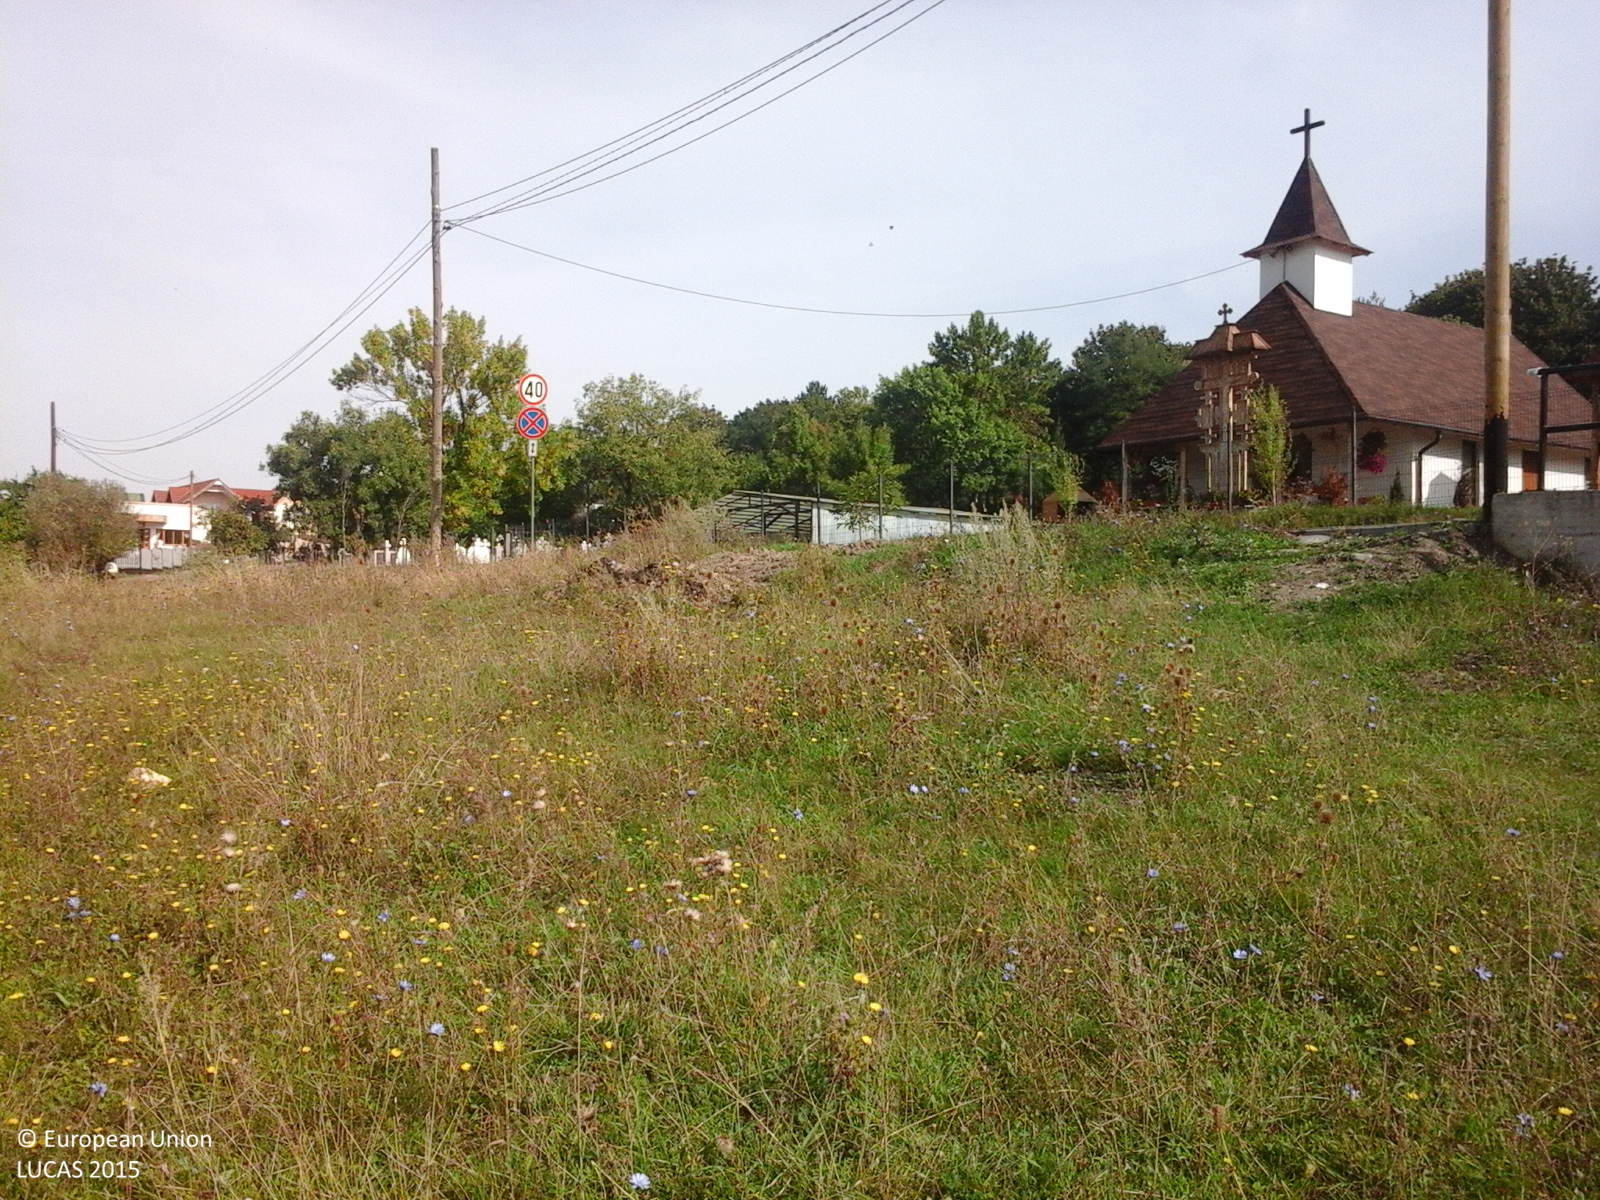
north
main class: Grassland
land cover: Grassland without tree/shrub cover
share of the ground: > 75 %
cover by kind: herbaceous plants 100 %
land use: Agriculture (excluding fallow land and kitchen gardens)
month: September
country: RO
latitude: 46.8091
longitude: 23.6087
